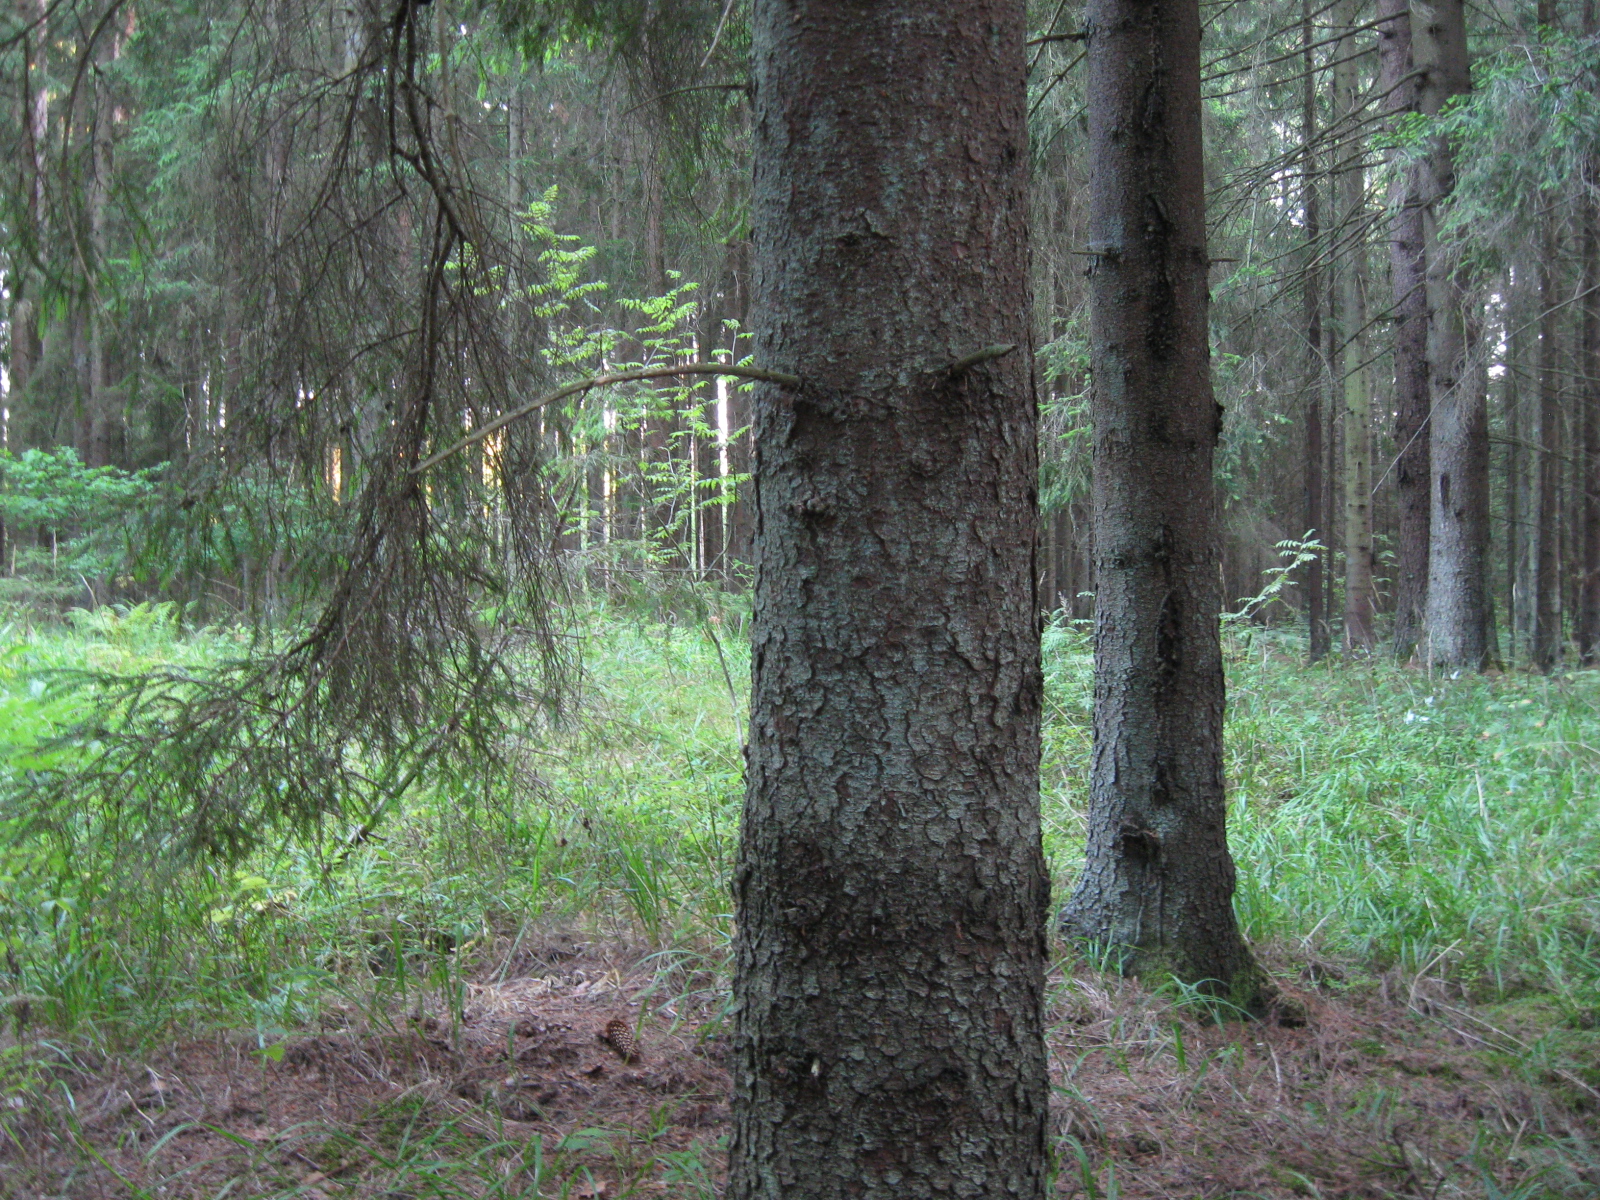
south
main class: Woodland
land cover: Spruce dominated coniferous woodland
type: hemiboreal forest and nemoral coniferous forest and mixed broadleaved-coniferous forest
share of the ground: > 75 %
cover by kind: coniferous forest trees 80 %, lichens and mosses 10 %, herbaceous plants 5 %, unconsolidated bare surface 5 %
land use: Forestry
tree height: > 5 m
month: August
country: LT
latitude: 54.7831
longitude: 23.4367
